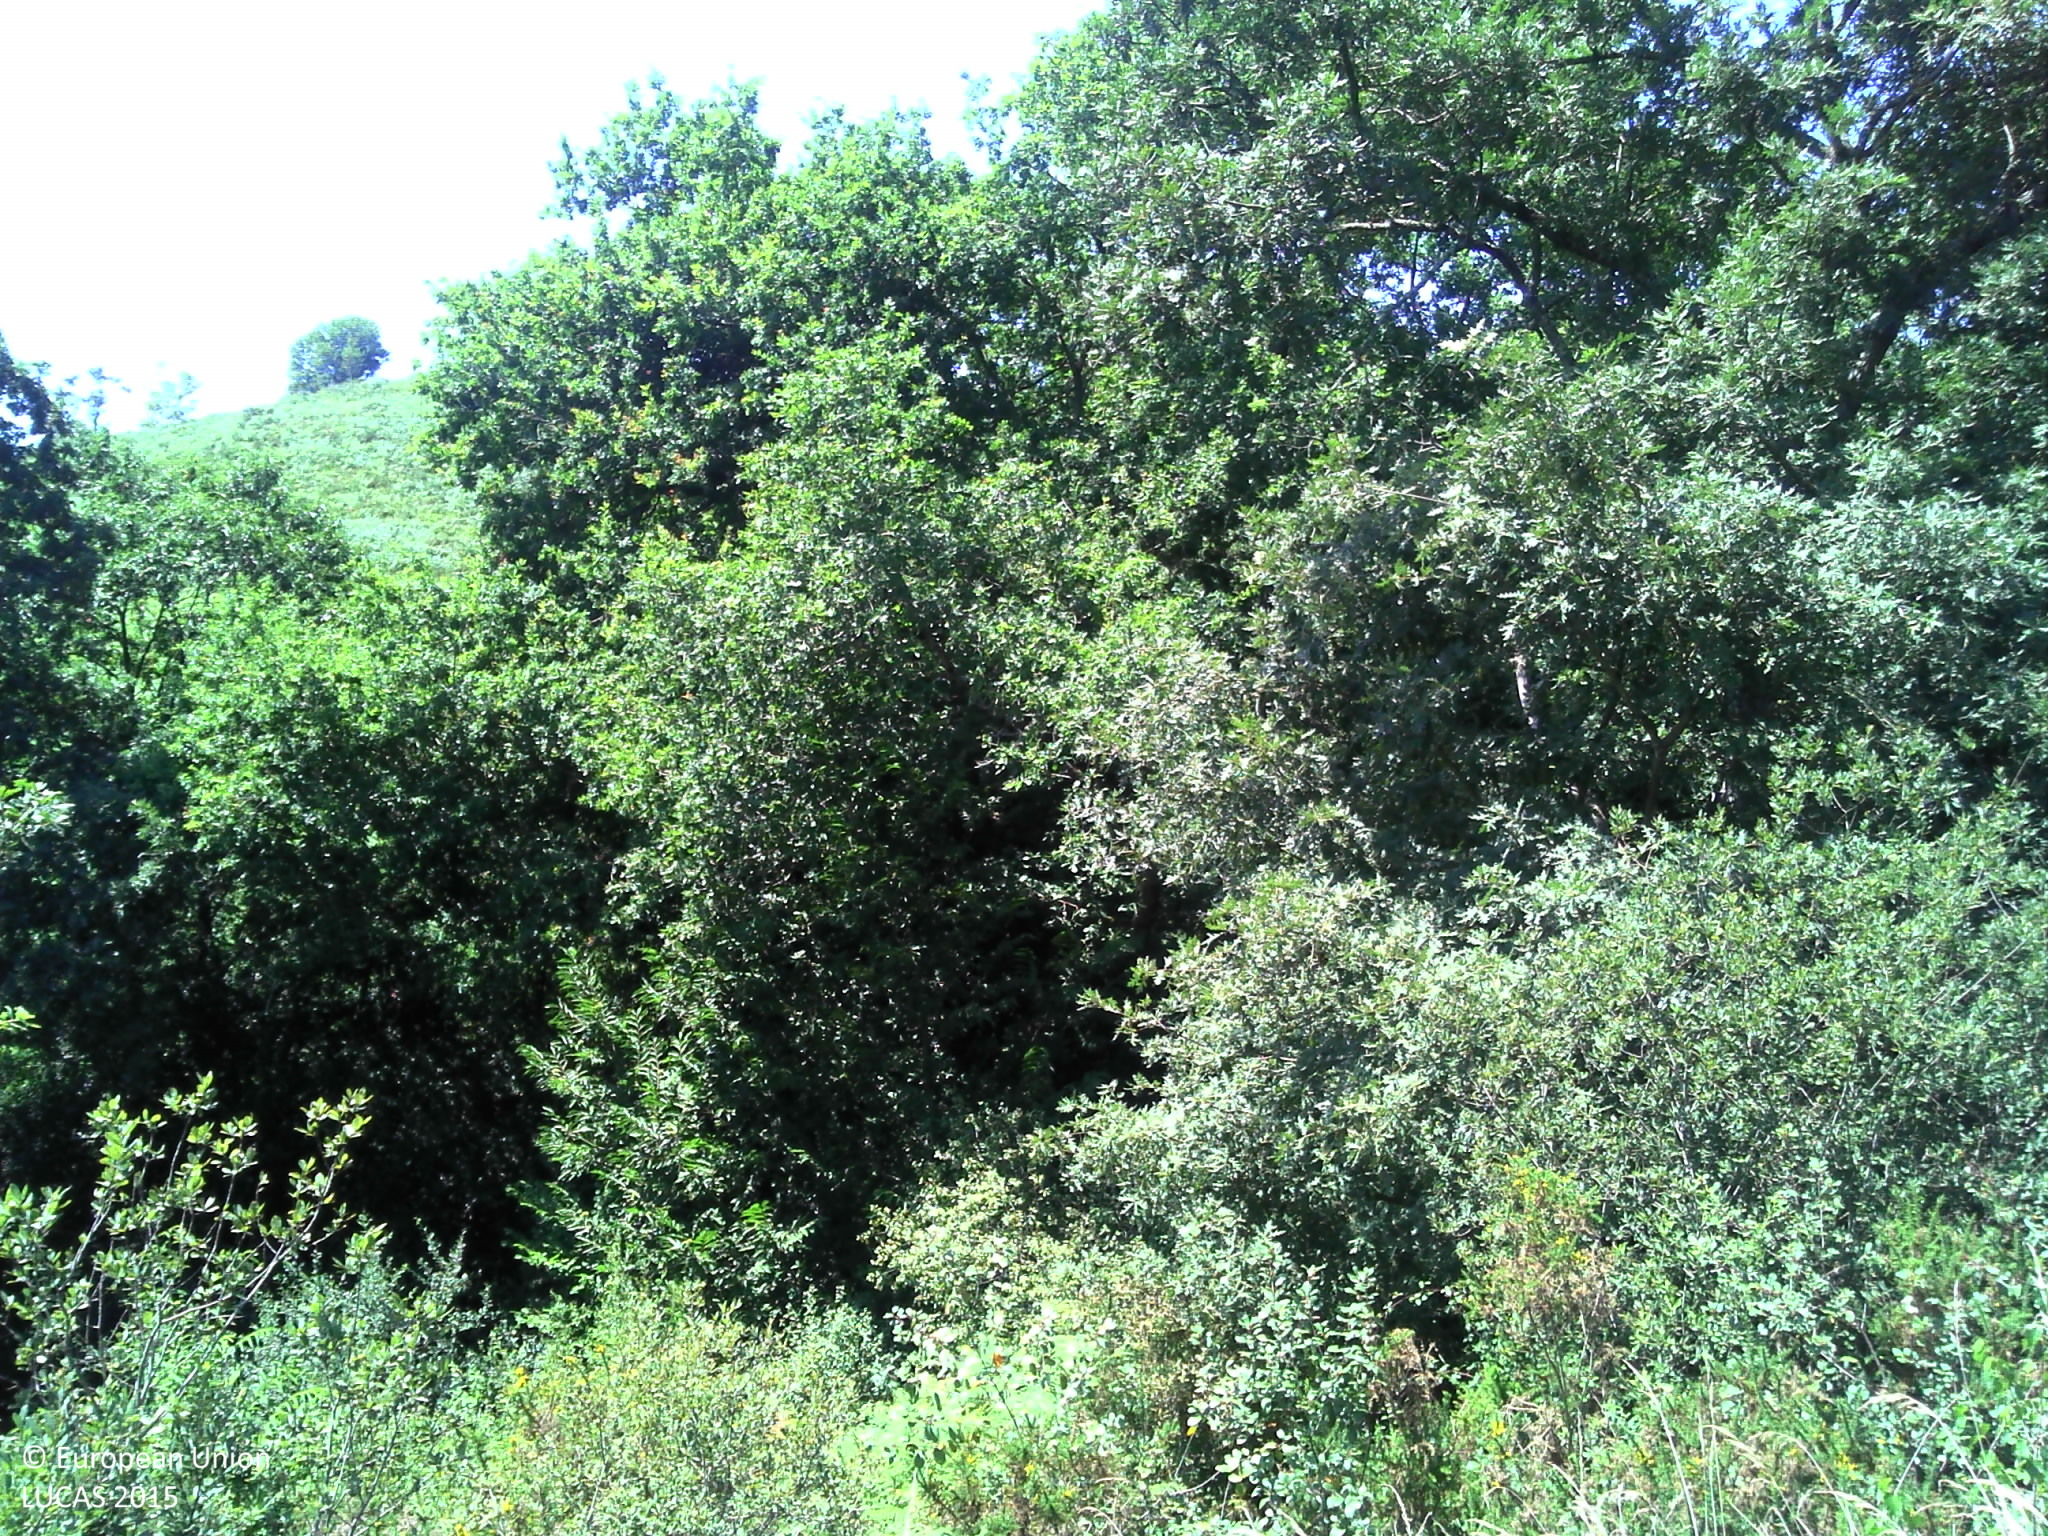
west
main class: Grassland
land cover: Grassland without tree/shrub cover
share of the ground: > 75 %
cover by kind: herbaceous plants 95 %, shrubs 5 %
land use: Agriculture (excluding fallow land and kitchen gardens)
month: August
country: FR
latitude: 43.3318
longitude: -1.1259
